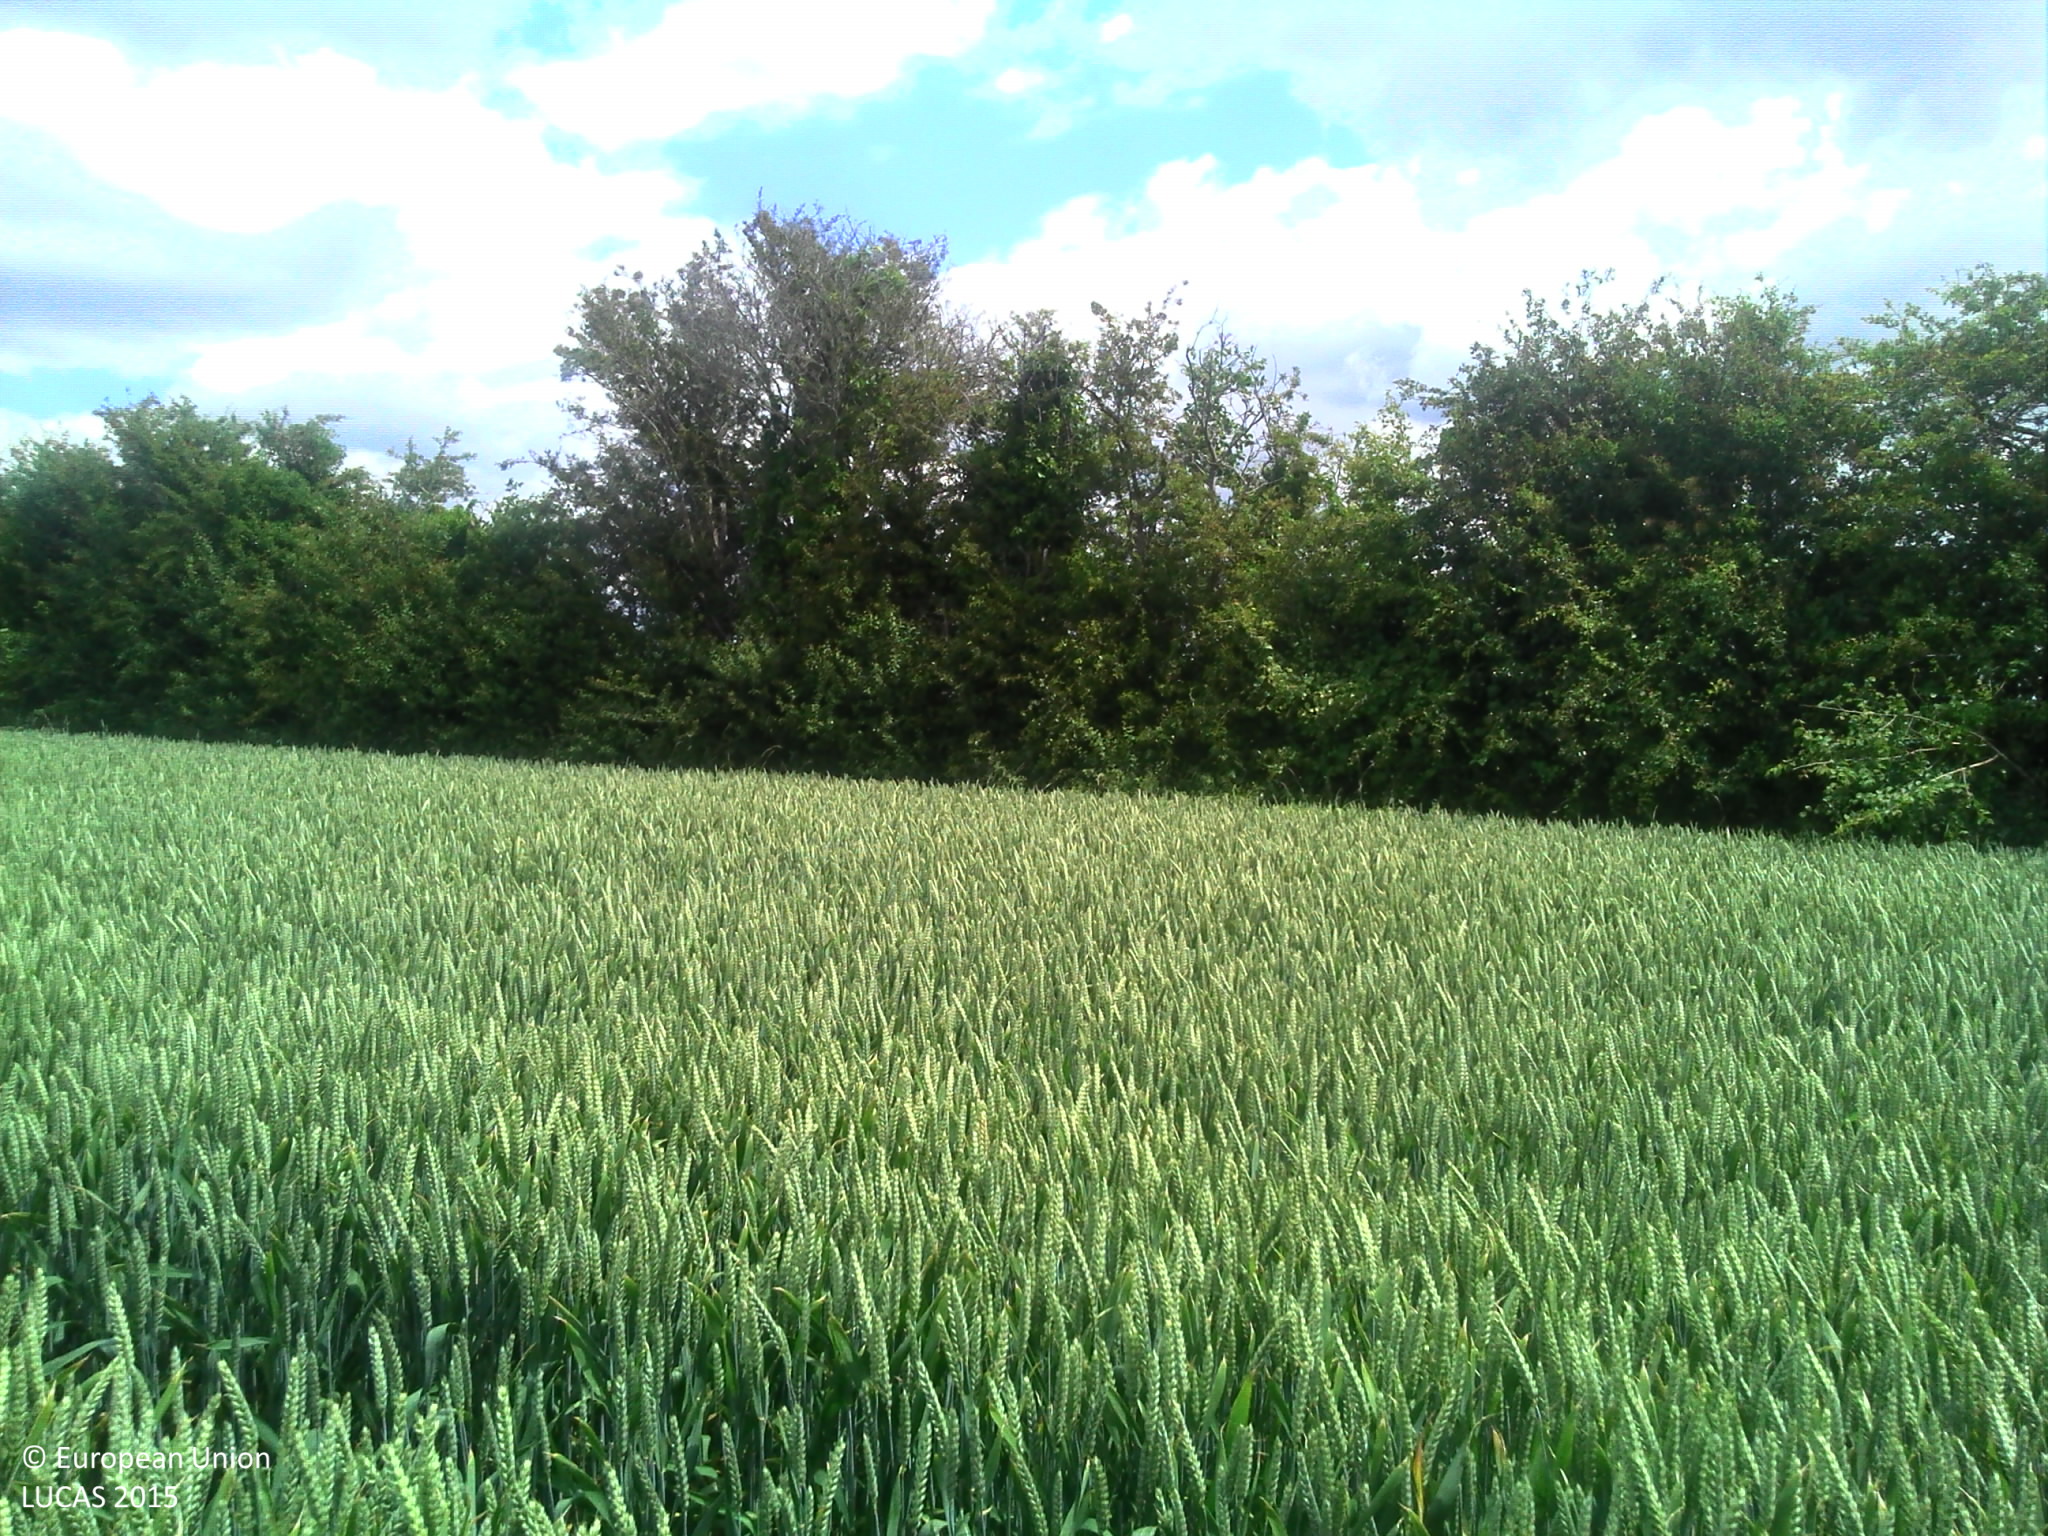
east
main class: Cropland
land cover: Common wheat
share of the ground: > 75 %
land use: Agriculture (excluding fallow land and kitchen gardens)
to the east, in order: Common wheat; Abandoned hedges; Ditches and canals; Grass margins; Paved roads, cycling and walking lanes; Grass margins; Ditches and canals; Abandoned hedges; Maize; Abandoned hedges; Grassland without tree/shrub cover; Tracks; Grassland without tree/shrub cover; Abandoned hedges; Grassland without tree/shrub cover
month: June
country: FR
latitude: 49.3450
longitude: -1.6826
